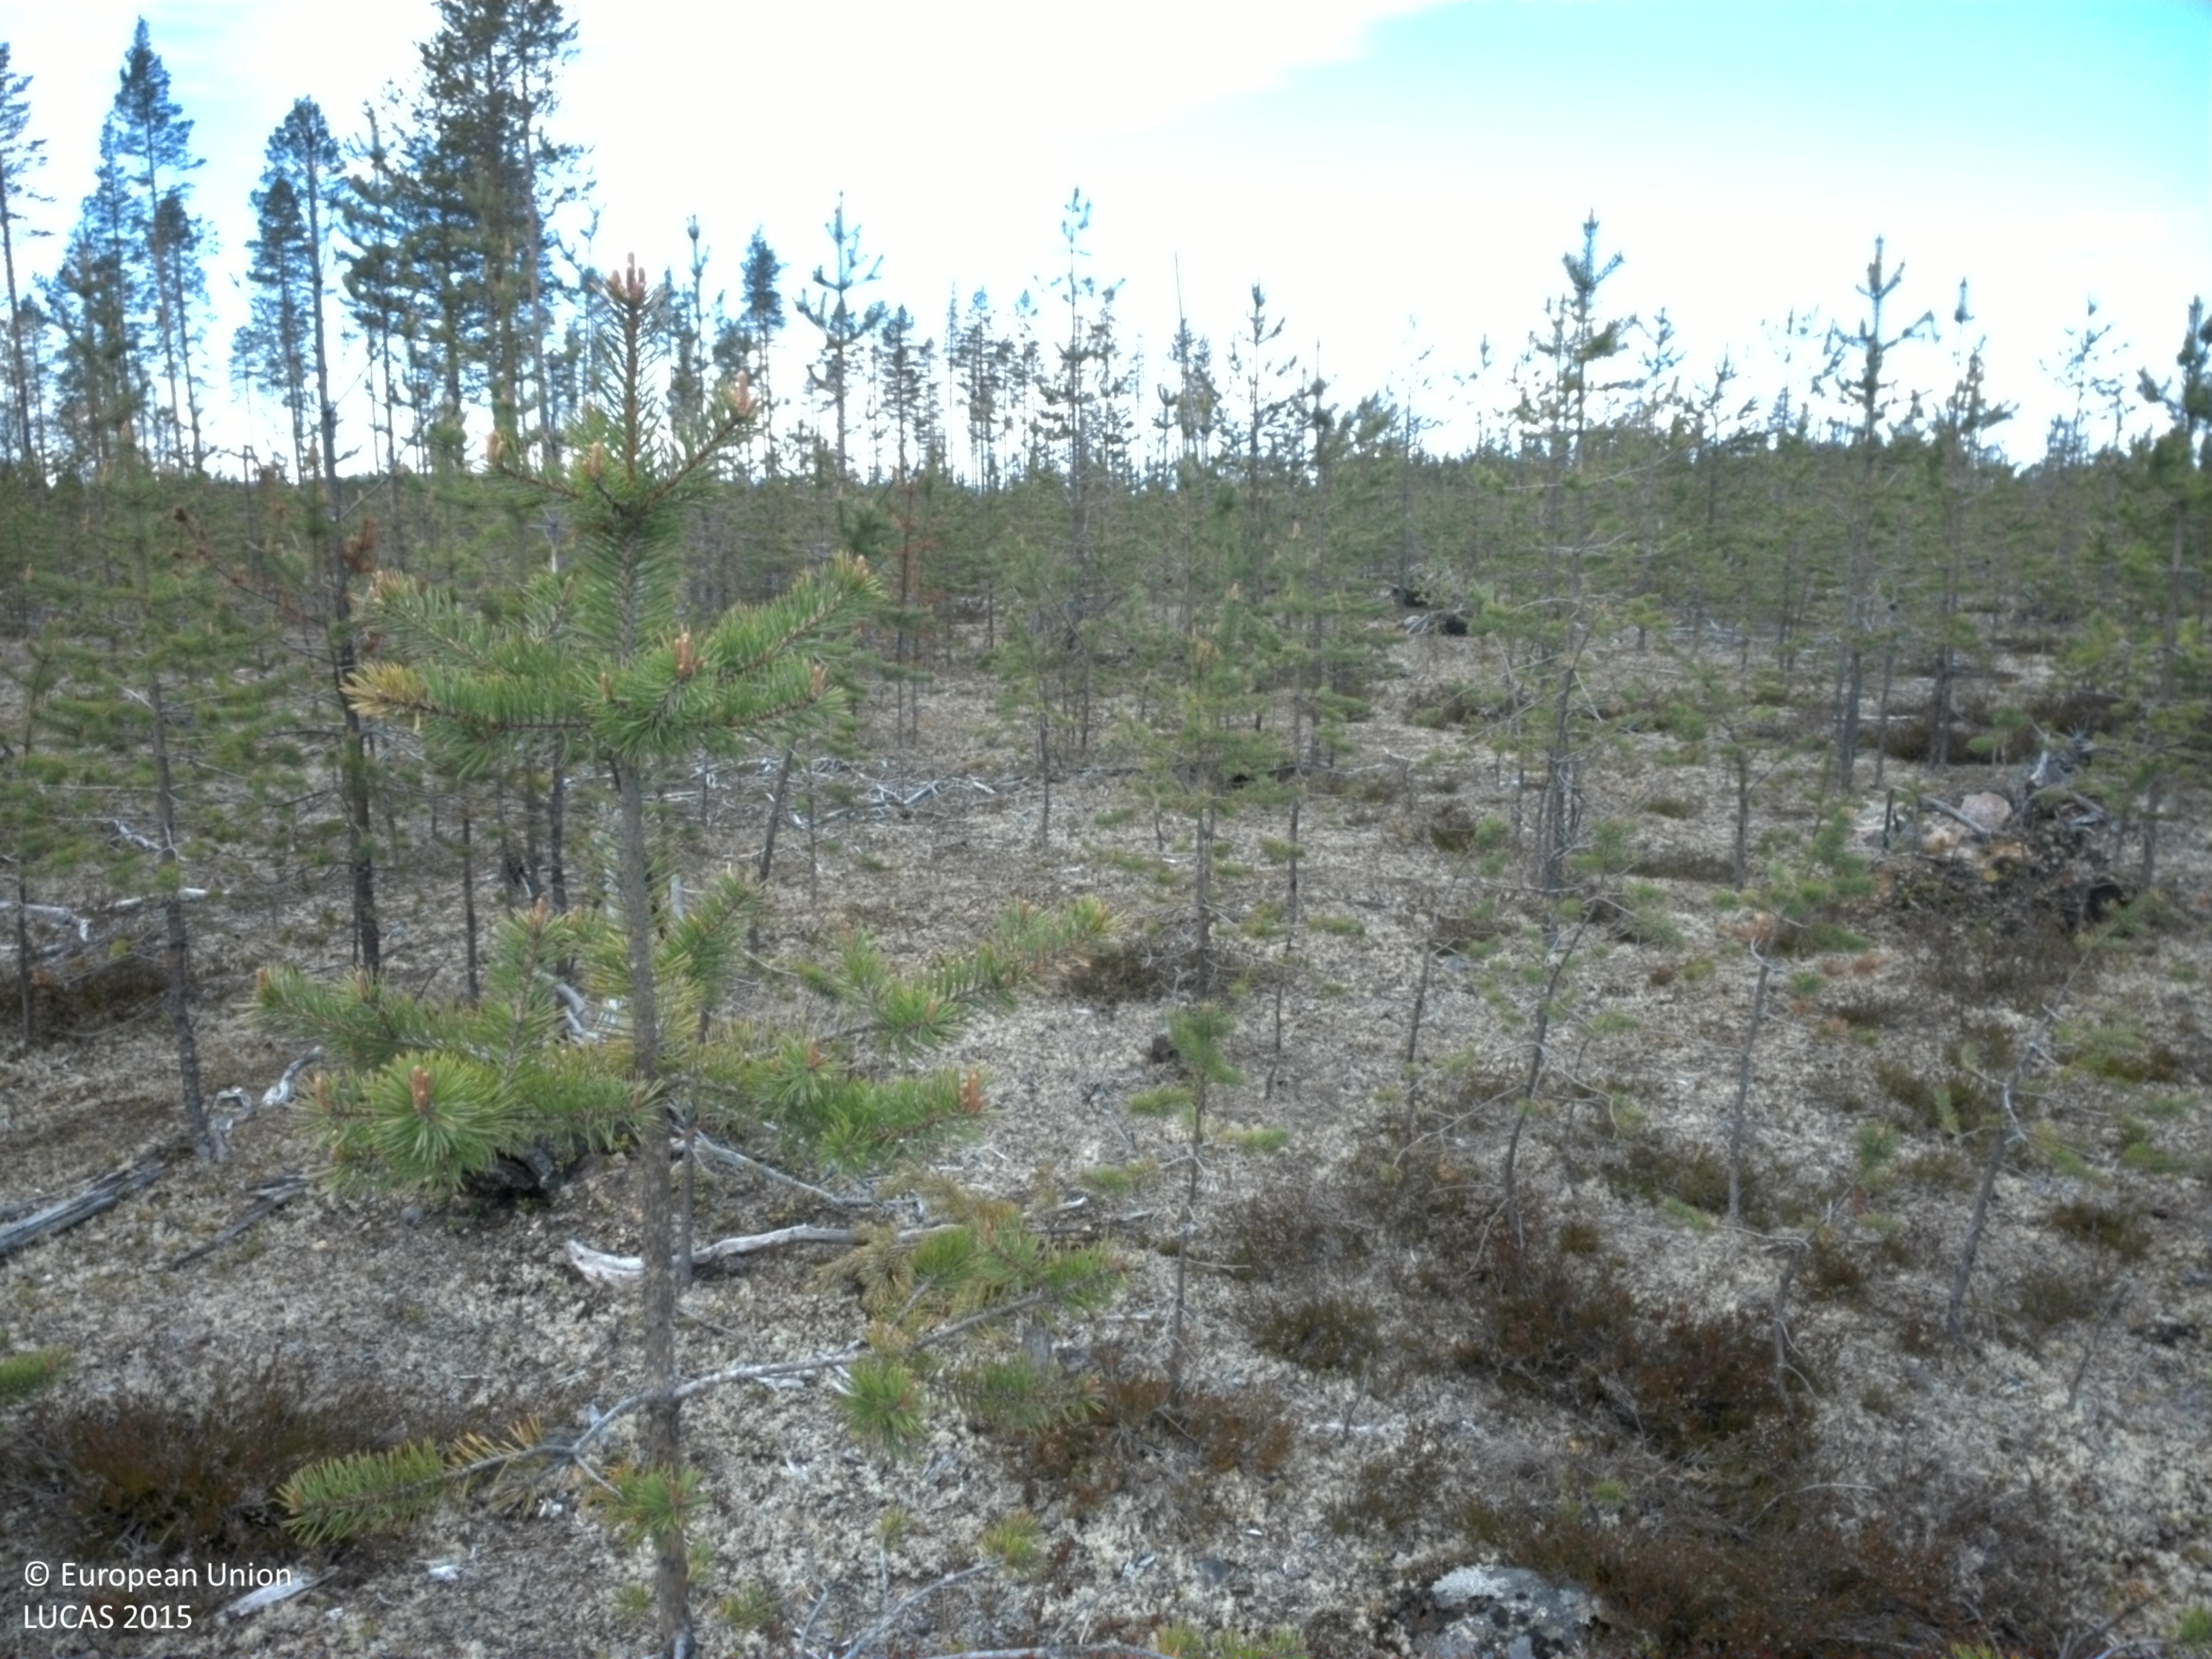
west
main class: Woodland
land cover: Pine dominated coniferous woodland
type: boreal forest
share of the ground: 25 - 50 %
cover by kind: coniferous forest trees 40 %, lichens and mosses 40 %, shrubs 20 %
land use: Forestry
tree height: < 5 m
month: June
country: SE
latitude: 66.5119
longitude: 22.4500
